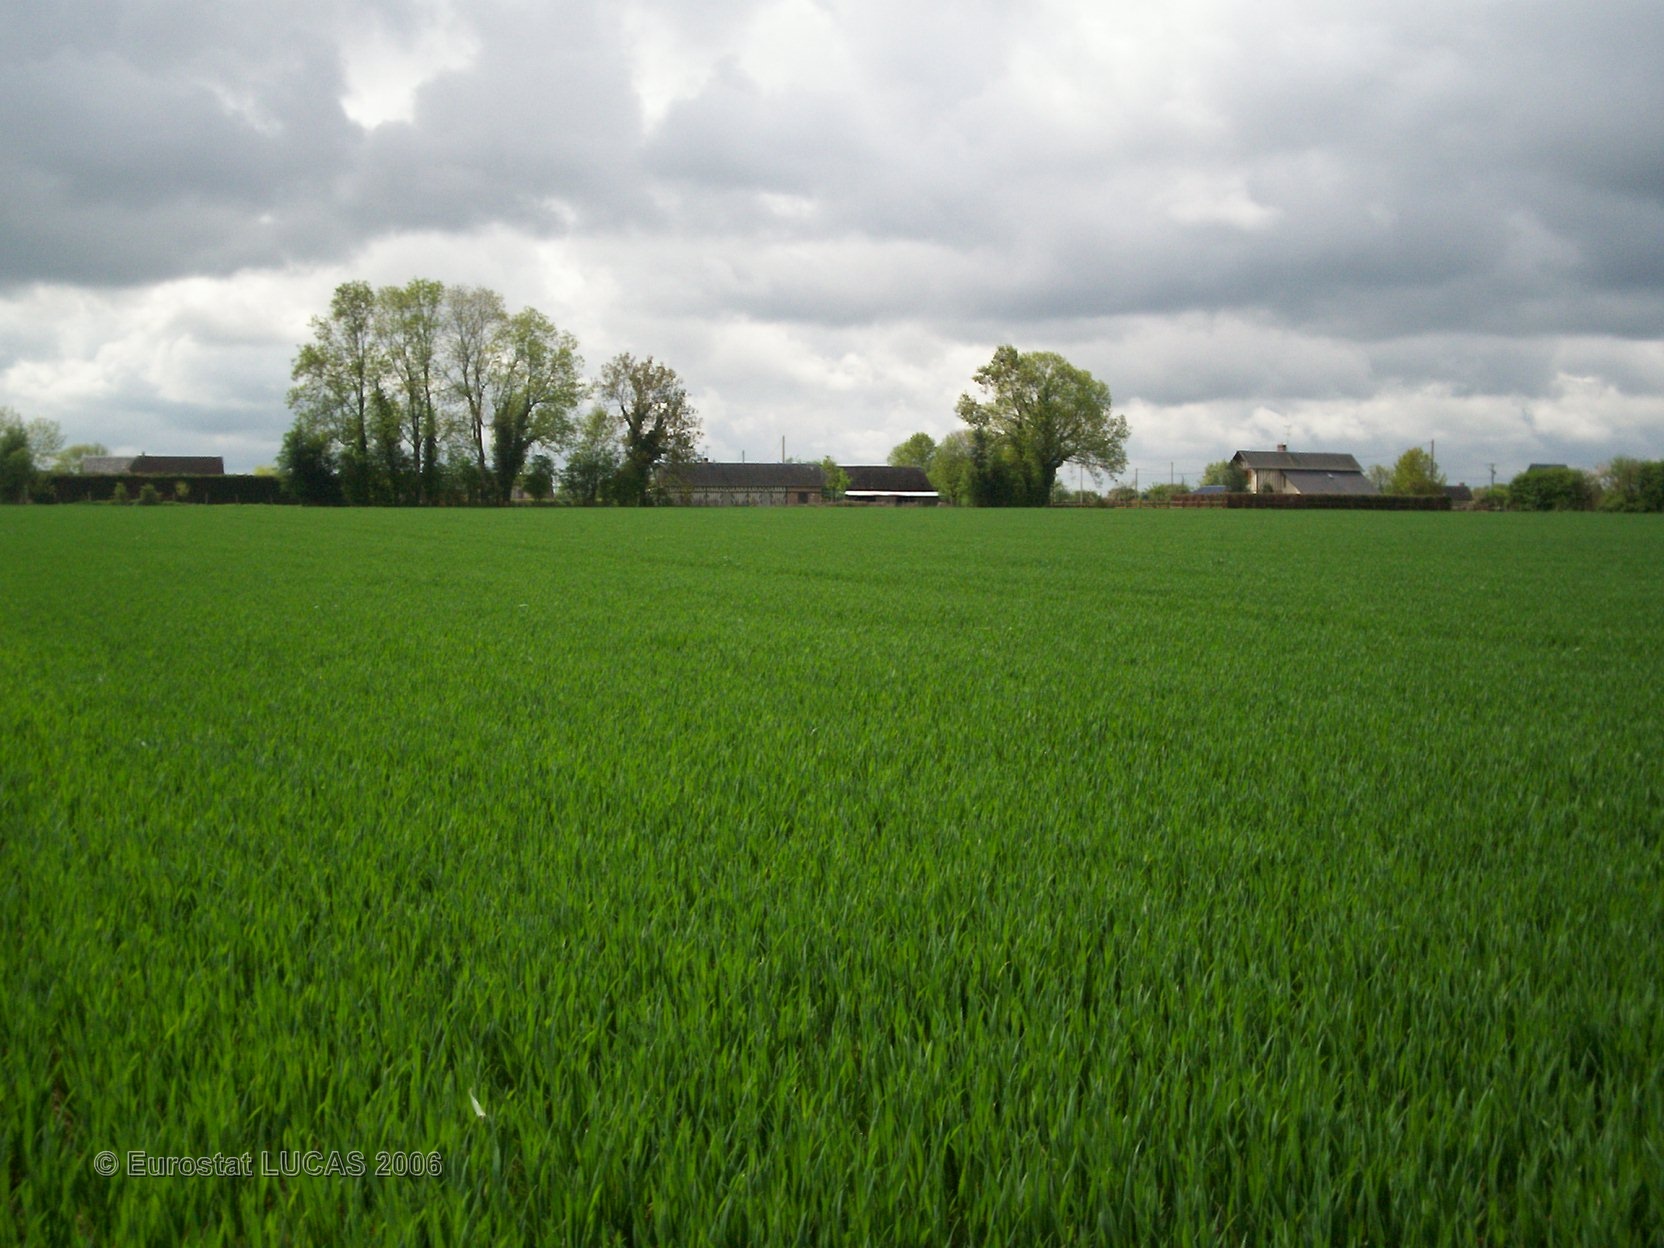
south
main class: Cropland
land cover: Common wheat
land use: Agriculture (excluding fallow land and kitchen gardens)
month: May
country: FR
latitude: 49.0638
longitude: 0.5168
